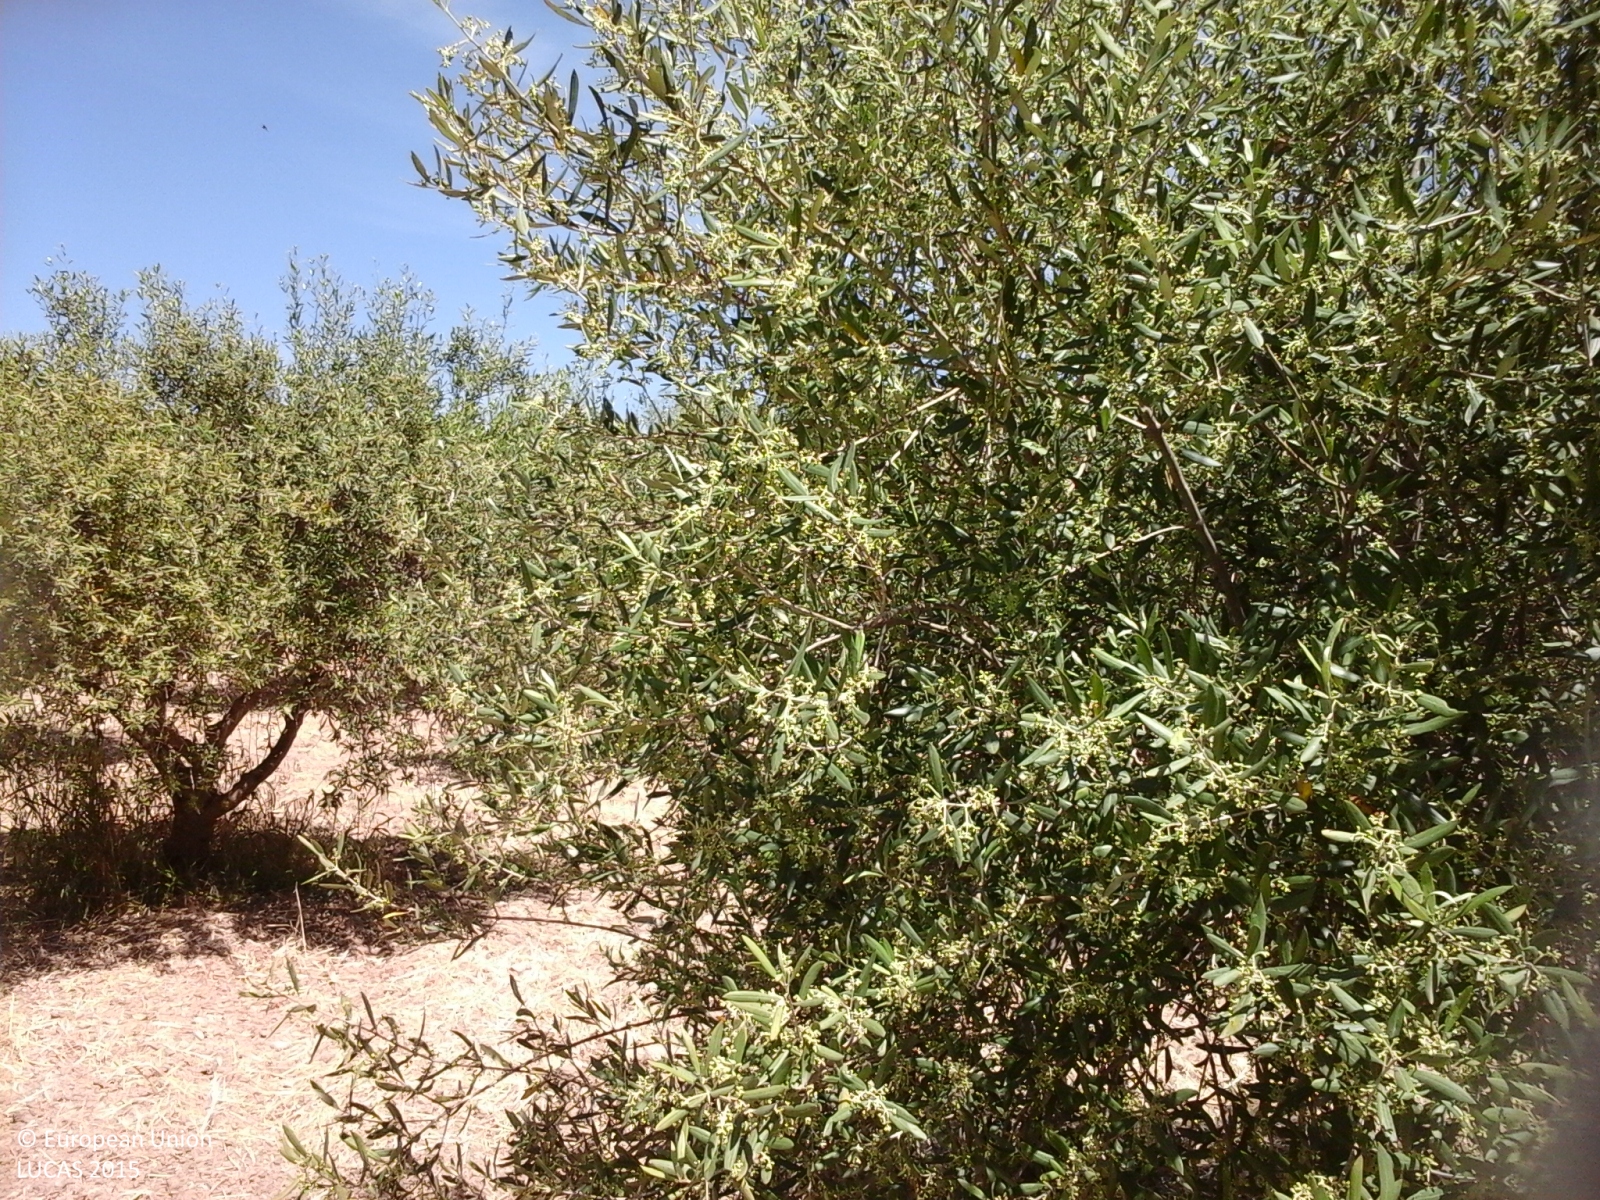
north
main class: Cropland
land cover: Olive groves
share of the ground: > 75 %
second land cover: Other bare soil
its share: > 75 %
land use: Agriculture (excluding fallow land and kitchen gardens)
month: May
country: IT
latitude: 37.4641
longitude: 13.9837
